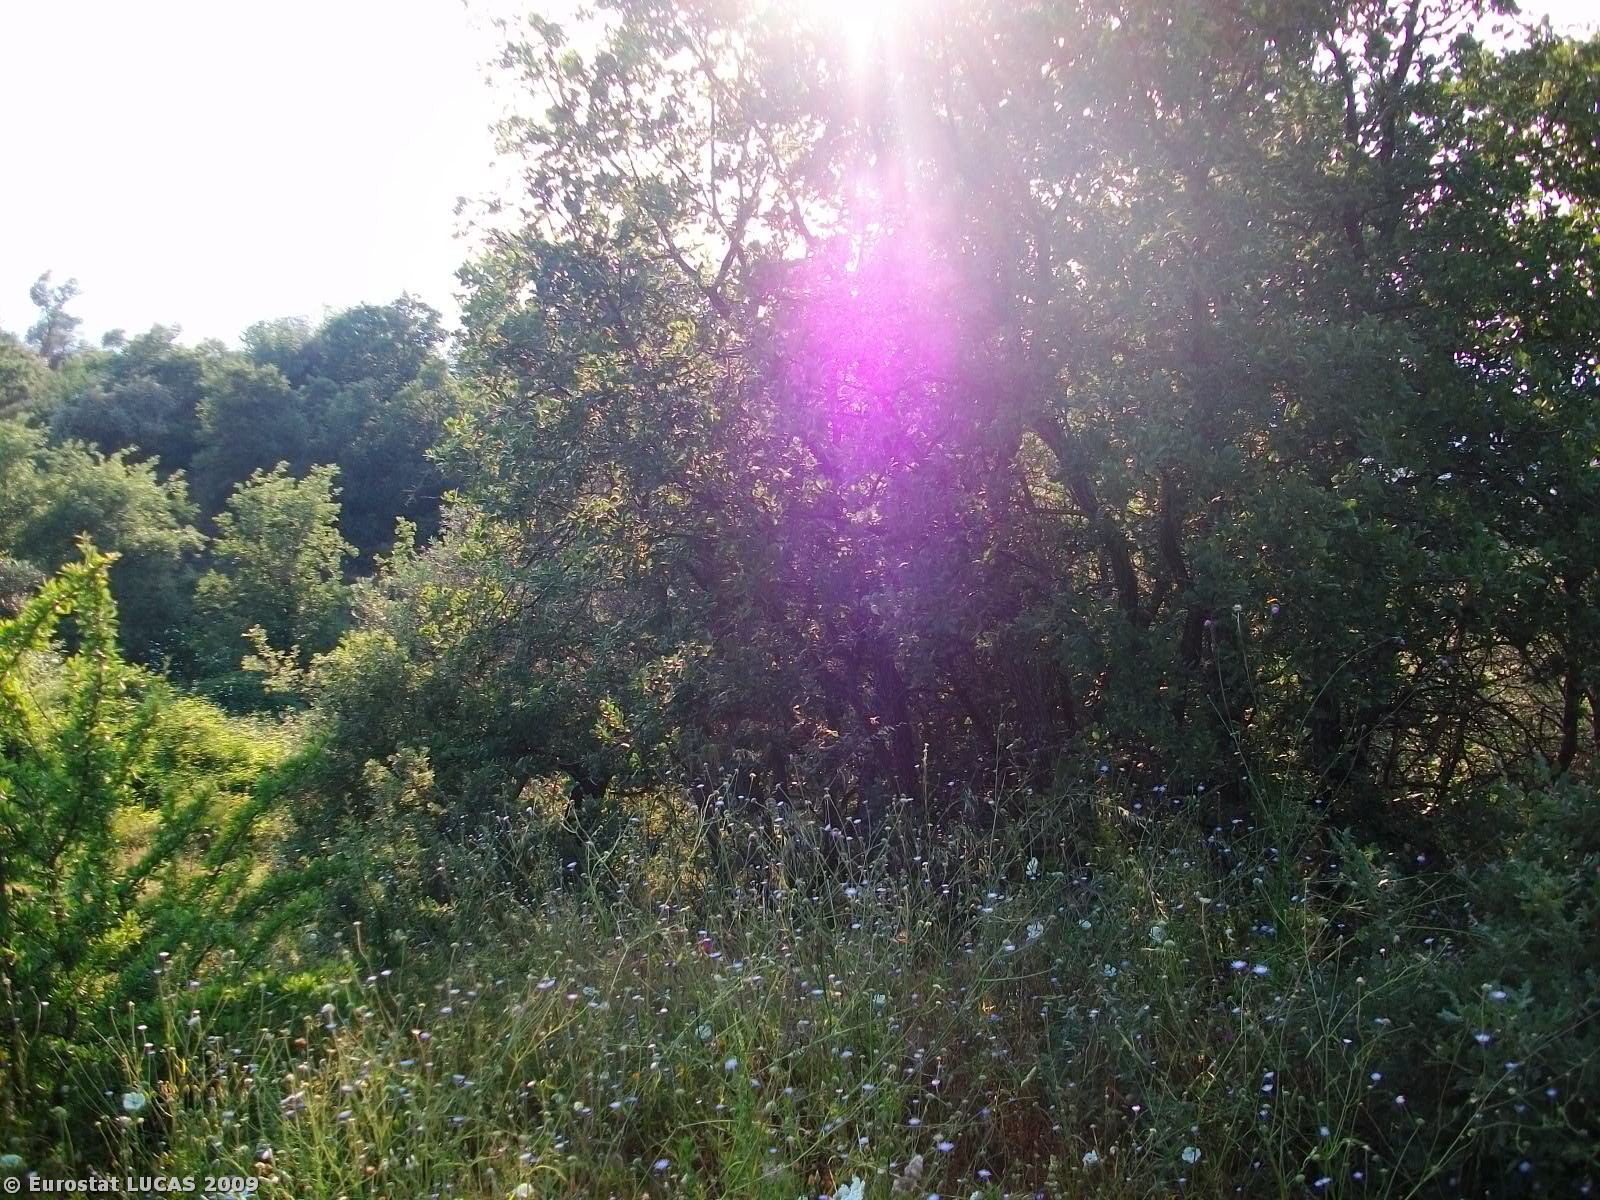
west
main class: Woodland
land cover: Broadleaved woodland
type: broadleaved evergreen forest
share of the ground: > 75 %
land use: Forestry
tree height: > 5 m
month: May
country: GR
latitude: 37.1793
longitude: 22.3355
